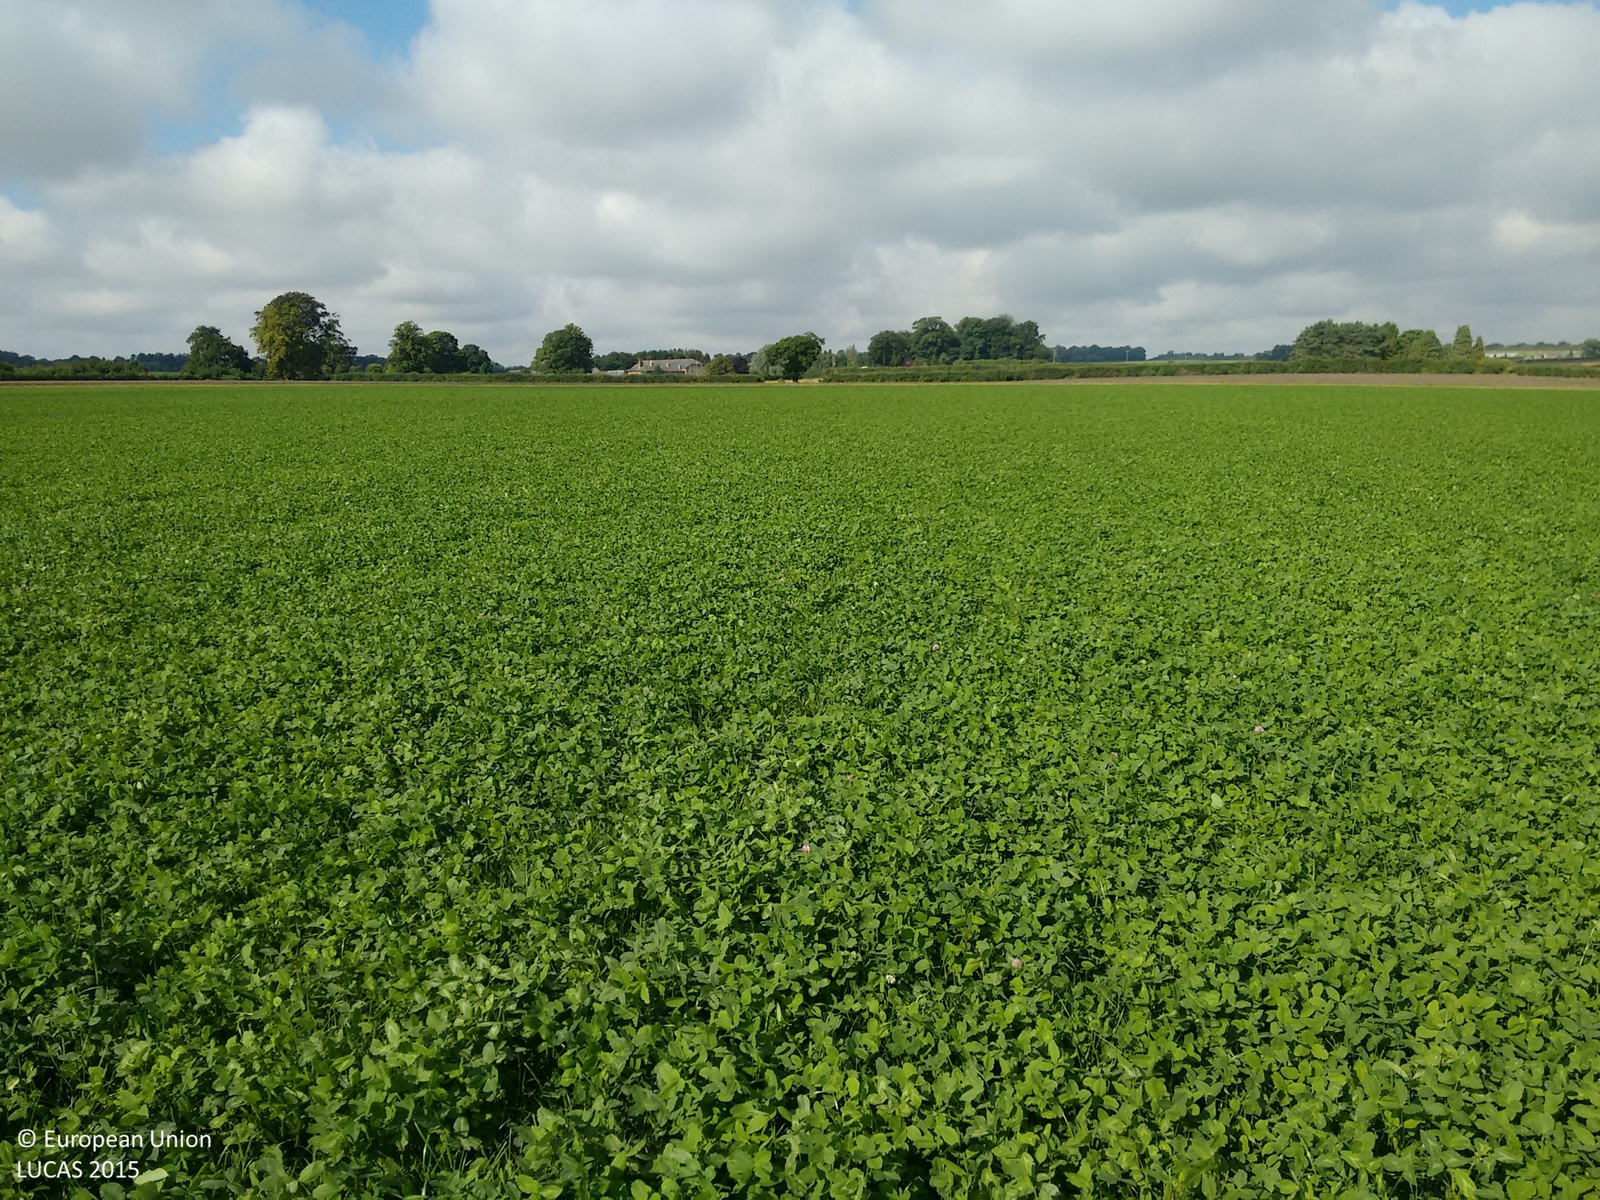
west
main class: Cropland
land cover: Clovers
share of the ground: > 75 %
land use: Agriculture (excluding fallow land and kitchen gardens)
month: September
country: GB
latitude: 52.2132
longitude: 0.5031
